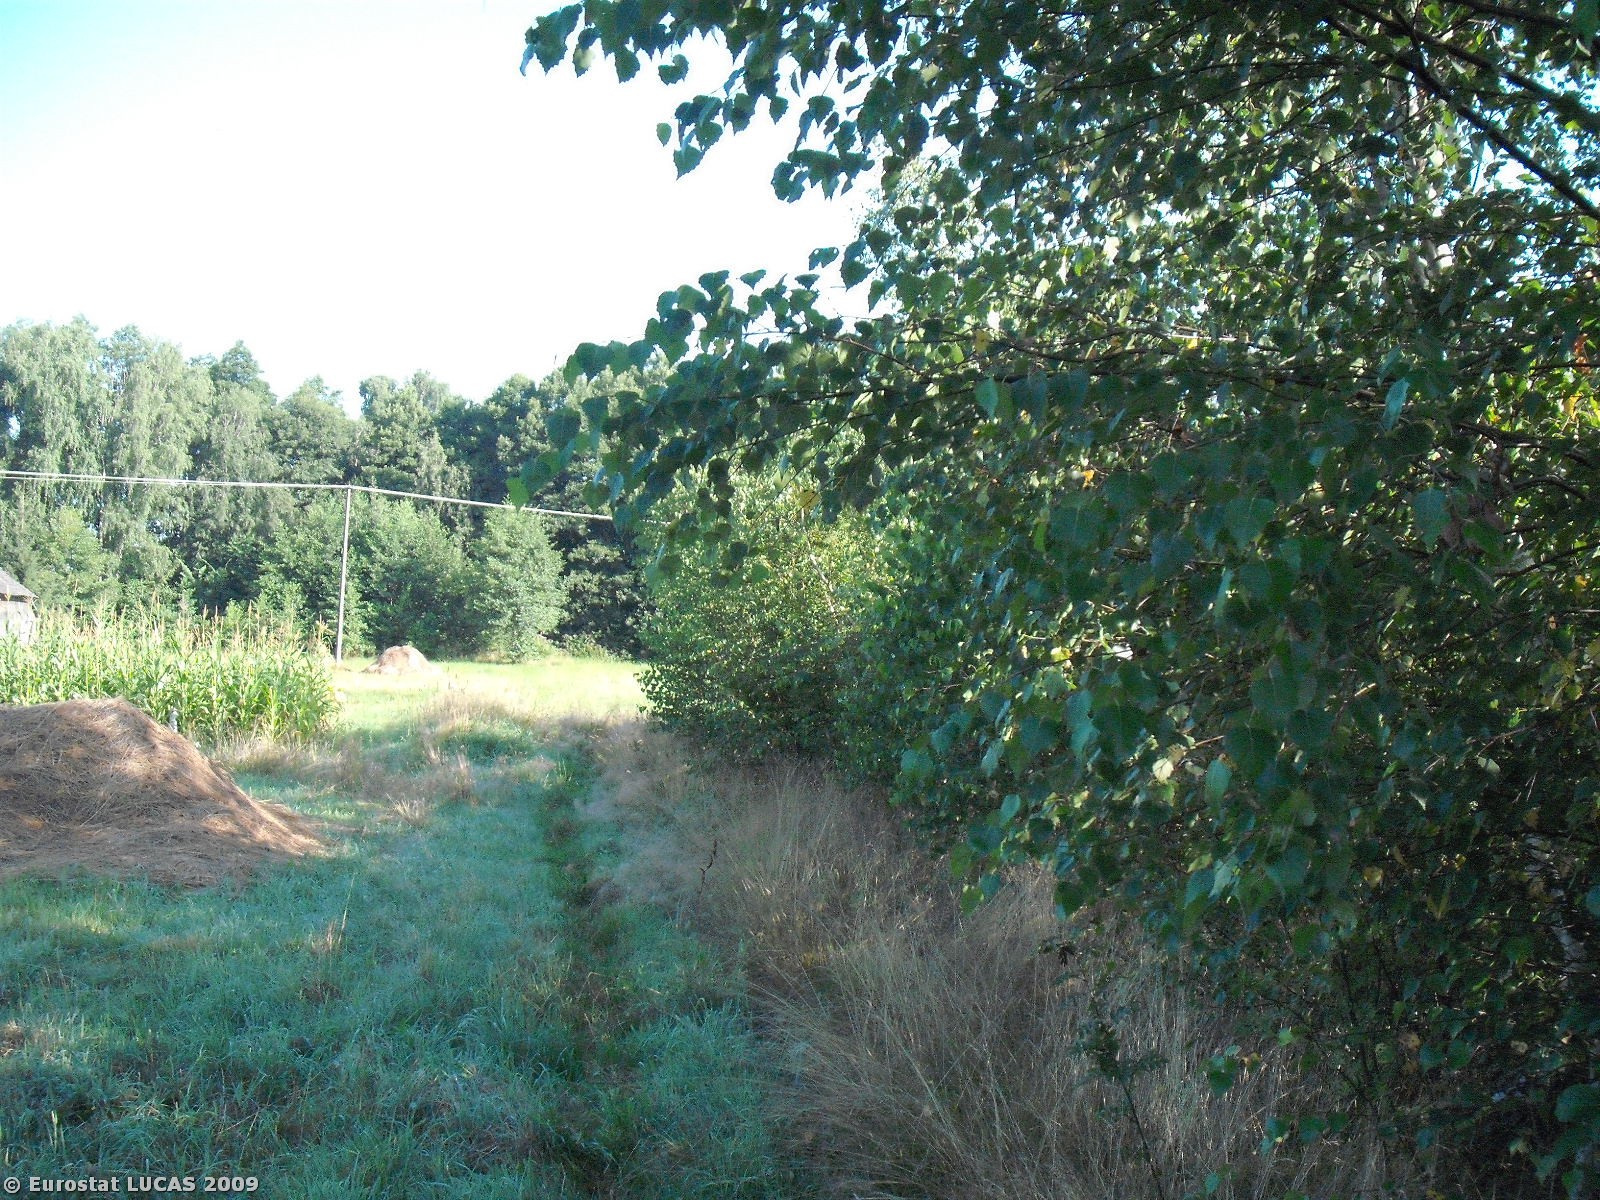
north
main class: Woodland
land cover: Broadleaved woodland
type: mesophytic deciduous forest
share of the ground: > 75 %
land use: Unused
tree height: > 5 m
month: August
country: PL
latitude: 50.1189
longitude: 22.1008
